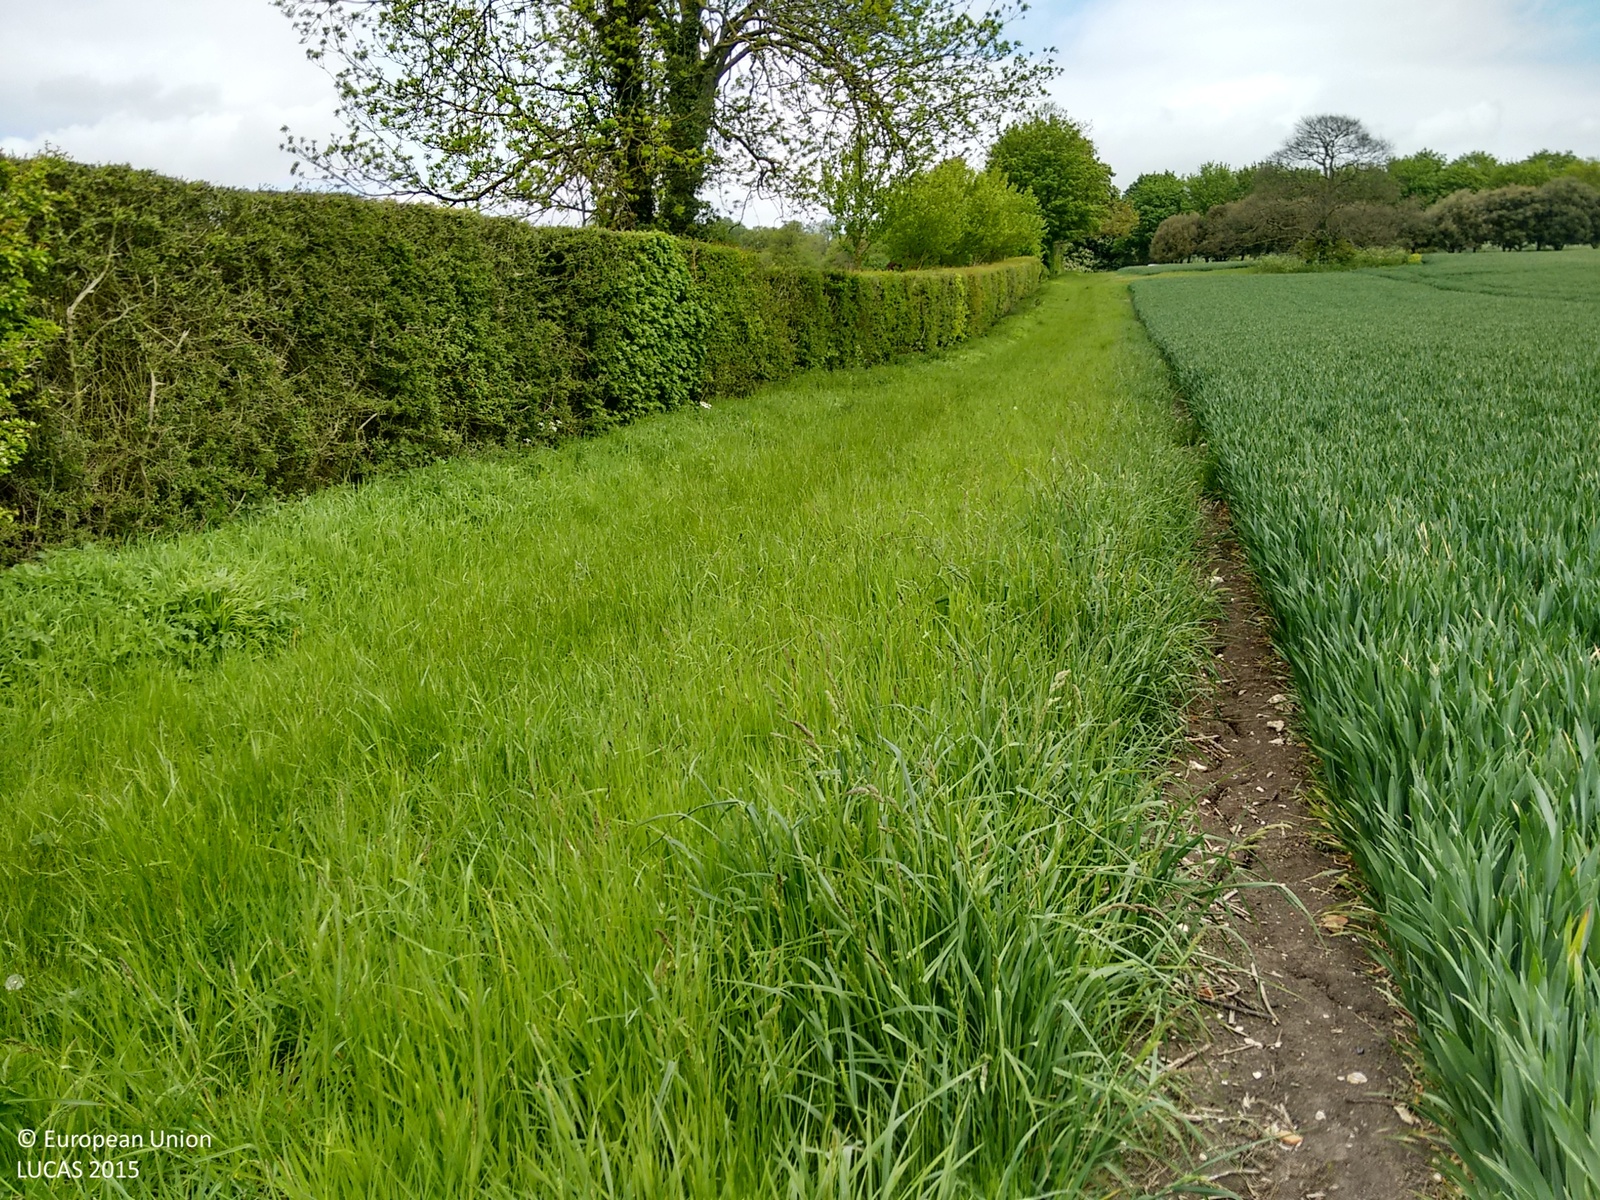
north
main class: Cropland
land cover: Common wheat
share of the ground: > 75 %
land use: Agriculture (excluding fallow land and kitchen gardens)
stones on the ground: < 10 %
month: May
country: GB
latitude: 51.3058
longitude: 0.2586
